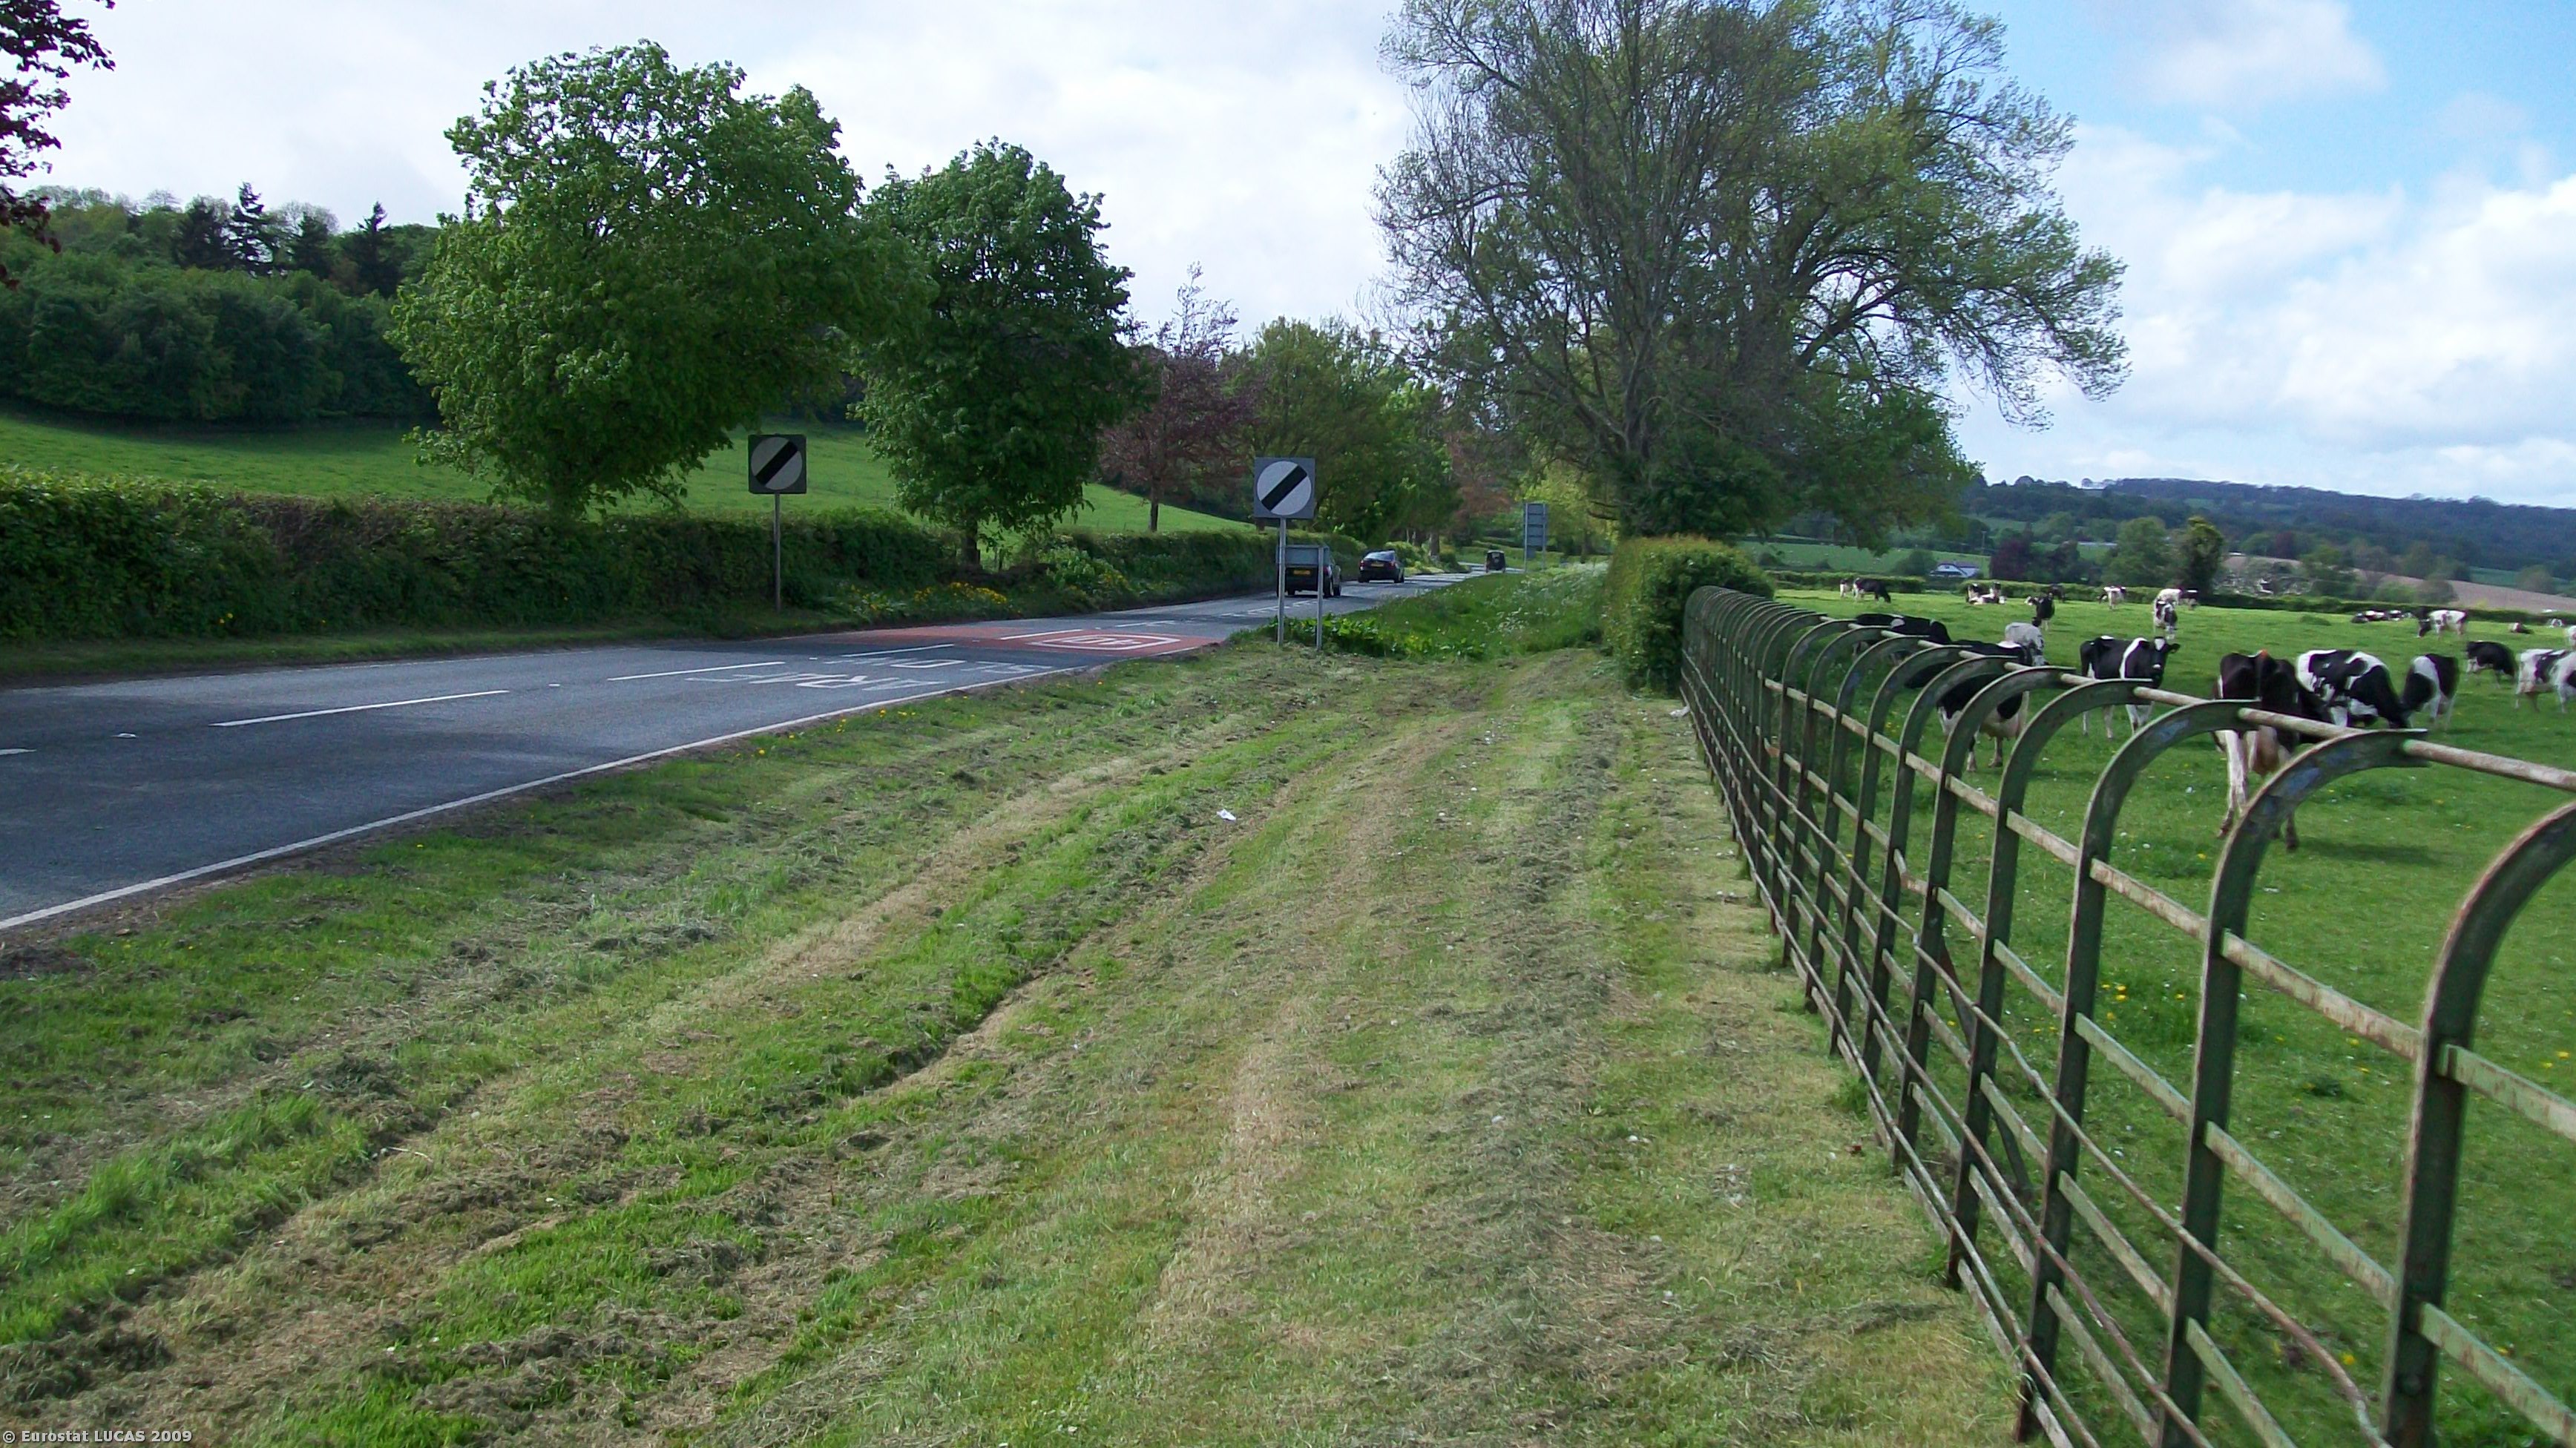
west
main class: Grassland
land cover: Grassland without tree/shrub cover
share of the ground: > 75 %
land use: Agriculture (excluding fallow land and kitchen gardens)
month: May
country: GB
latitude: 53.1338
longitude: -3.3387
